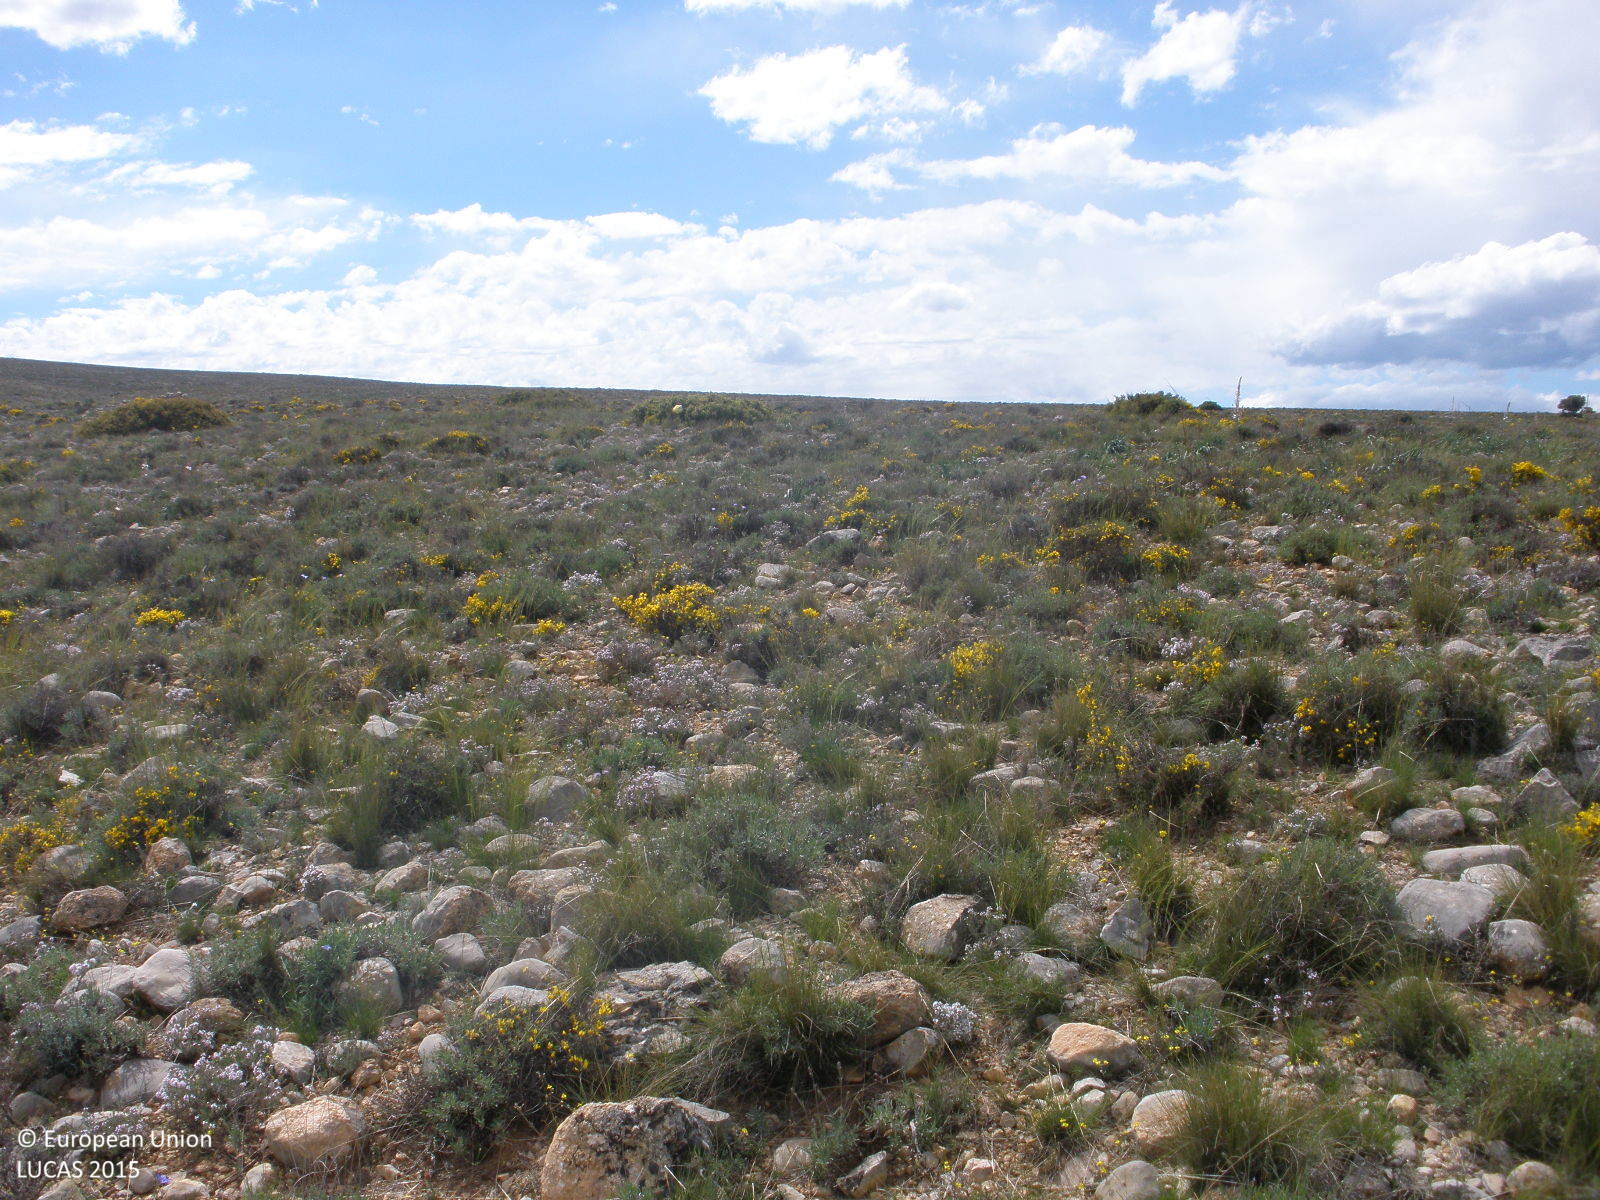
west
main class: Shrubland
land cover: Shrubland without tree cover
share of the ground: 25 - 50 %
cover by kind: shrubs 40 %, herbaceous plants 30 %, consolidated bare surface 30 %
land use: Semi-natural and natural areas not in use
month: May
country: ES
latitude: 41.0386
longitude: -0.9484
